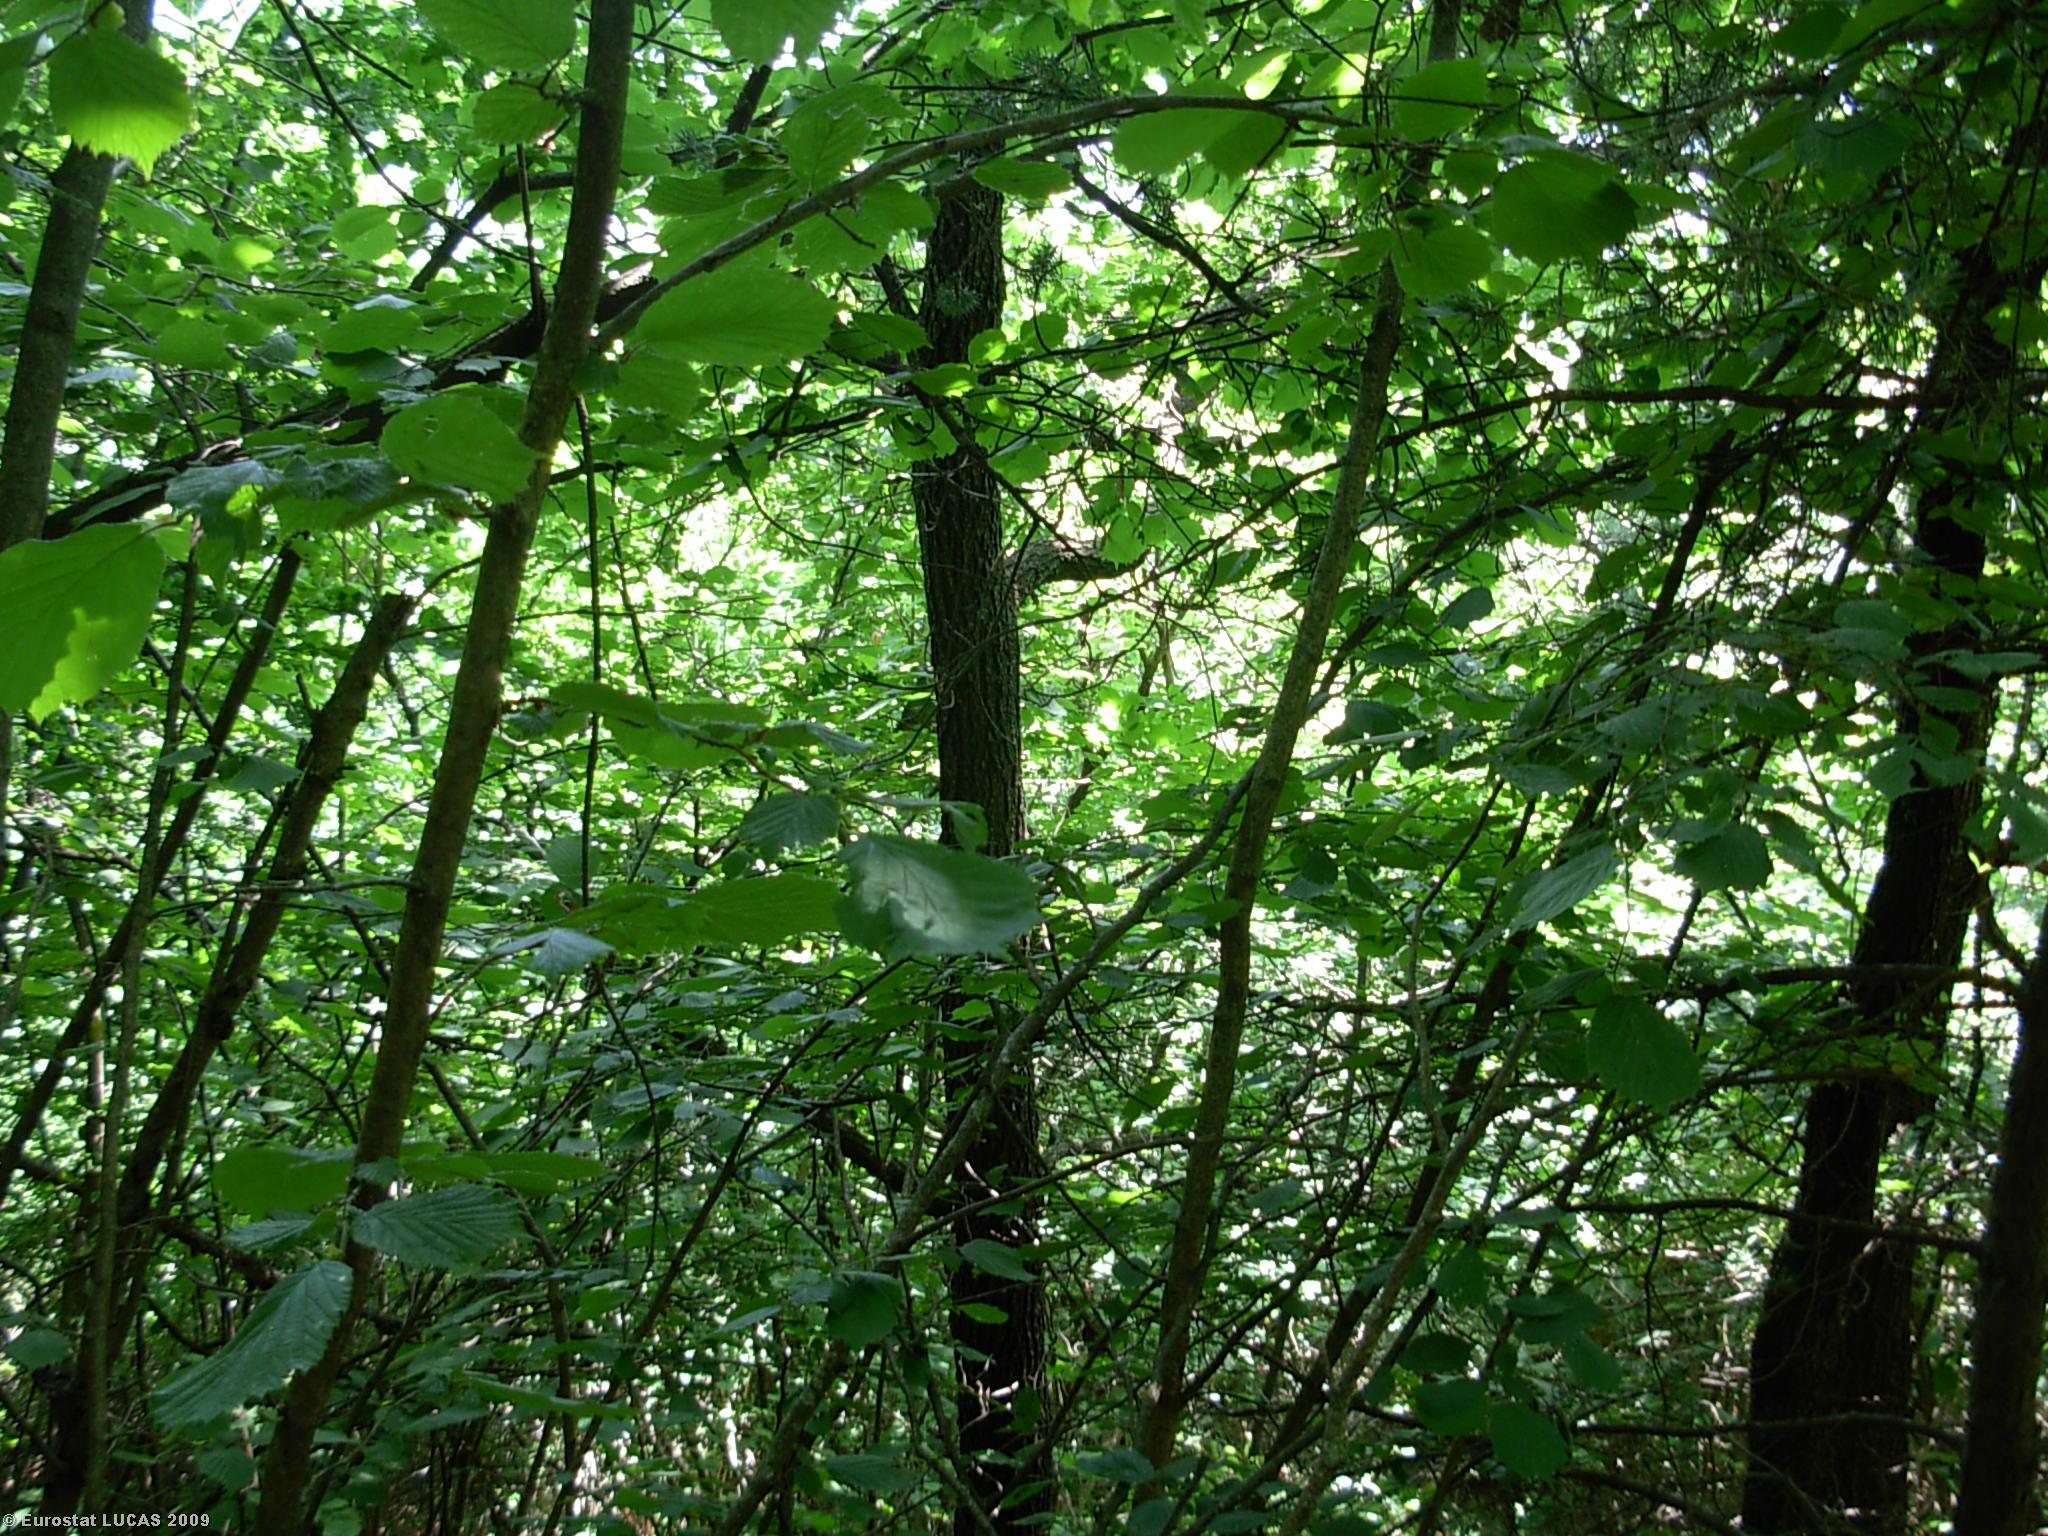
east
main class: Woodland
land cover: Broadleaved woodland
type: mountainous beech forest
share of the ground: > 75 %
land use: Unused
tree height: > 5 m
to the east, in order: Broadleaved woodland; Paved roads, cycling and walking lanes; Grassland with sparse tree/shrub cover; Electric lines; Grassland with sparse tree/shrub cover; Artificial constructions in urban areas; Grassland with sparse tree/shrub cover
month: June
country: IT
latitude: 45.7195
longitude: 10.5002
